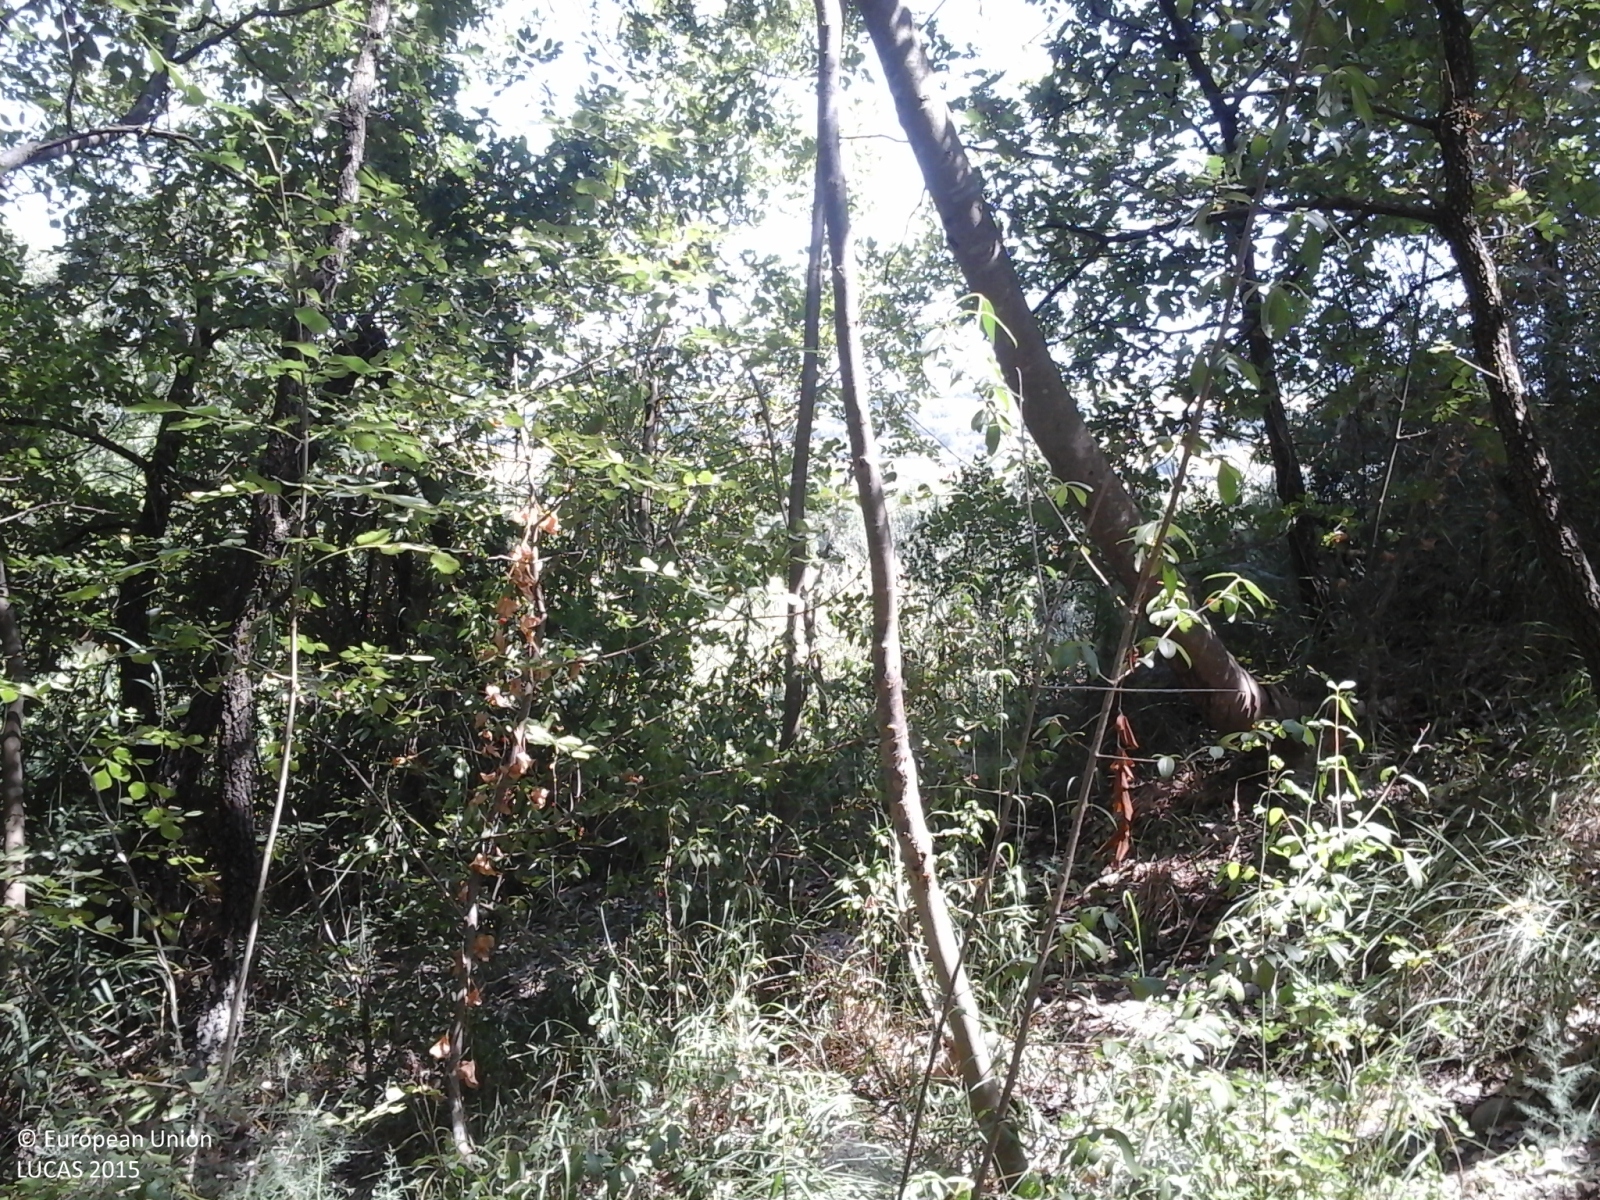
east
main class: Woodland
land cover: Broadleaved woodland
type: mesophytic deciduous forest
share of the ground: > 75 %
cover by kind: broadleaved forest trees 100 %
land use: Forestry
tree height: > 5 m
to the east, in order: Broadleaved woodland; Tracks; Broadleaved woodland; Tracks; Broadleaved woodland
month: July
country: IT
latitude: 43.9450
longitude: 12.3492
